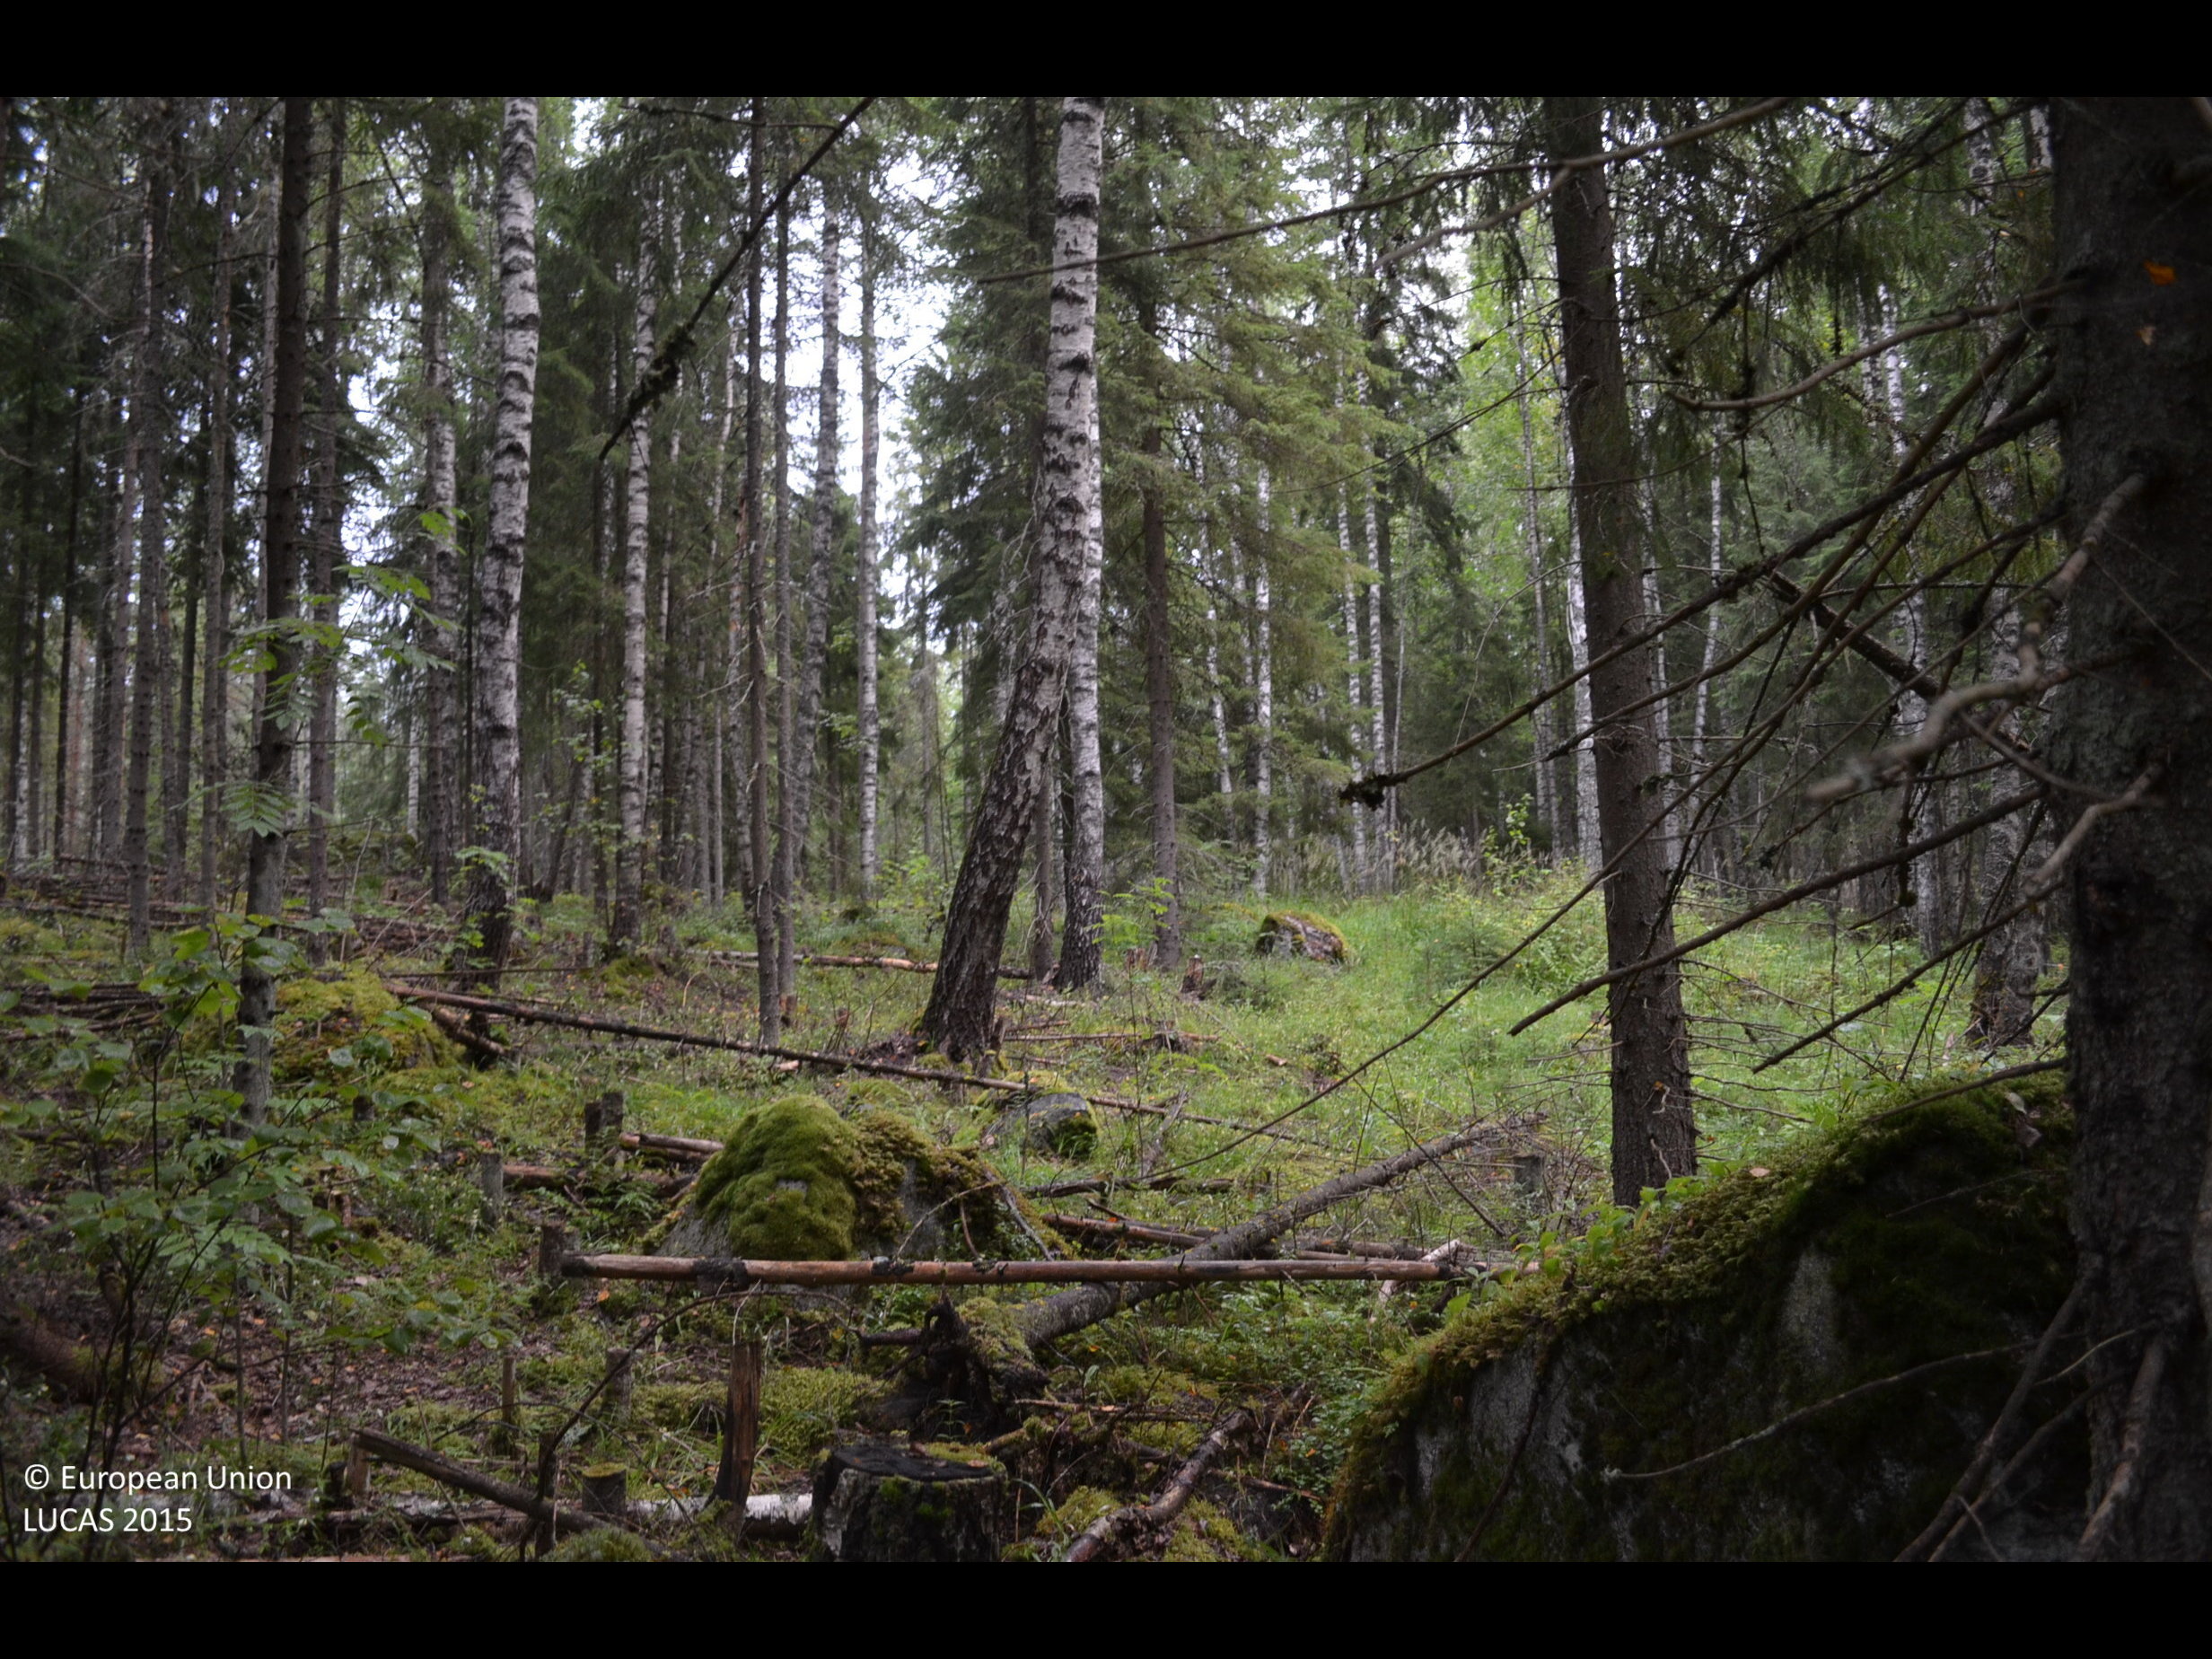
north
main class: Woodland
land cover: Spruce dominated mixed woodland
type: boreal forest
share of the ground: 50 - 75 %
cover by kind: broadleaved forest trees 40 %, coniferous forest trees 30 %, herbaceous plants 25 %, shrubs 5 %
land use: Forestry
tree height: > 5 m
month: August
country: FI
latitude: 61.5382
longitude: 23.1459
